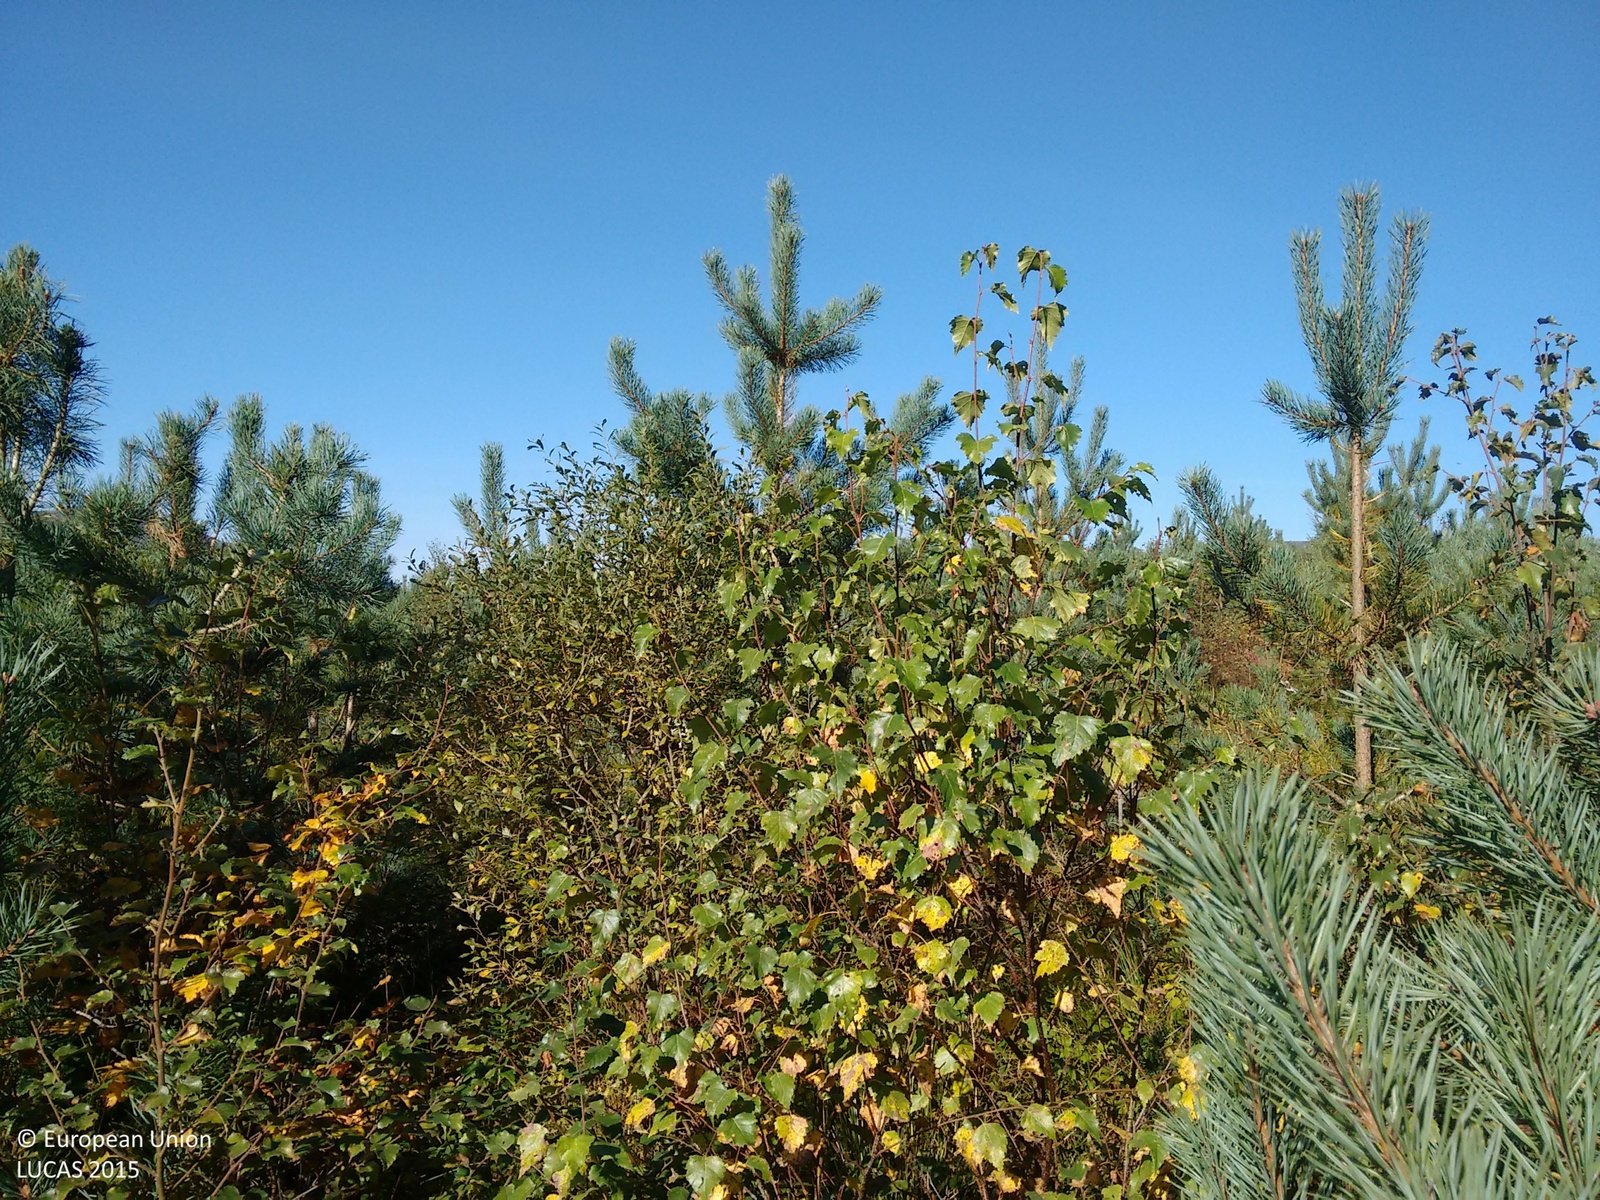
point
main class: Woodland
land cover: Pine dominated mixed woodland
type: exotic forest
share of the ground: > 75 %
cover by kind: coniferous forest trees 60 %, broadleaved forest trees 30 %, shrubs 10 %
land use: Forestry
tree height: < 5 m
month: September
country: GB
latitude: 56.0921
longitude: -4.4827
